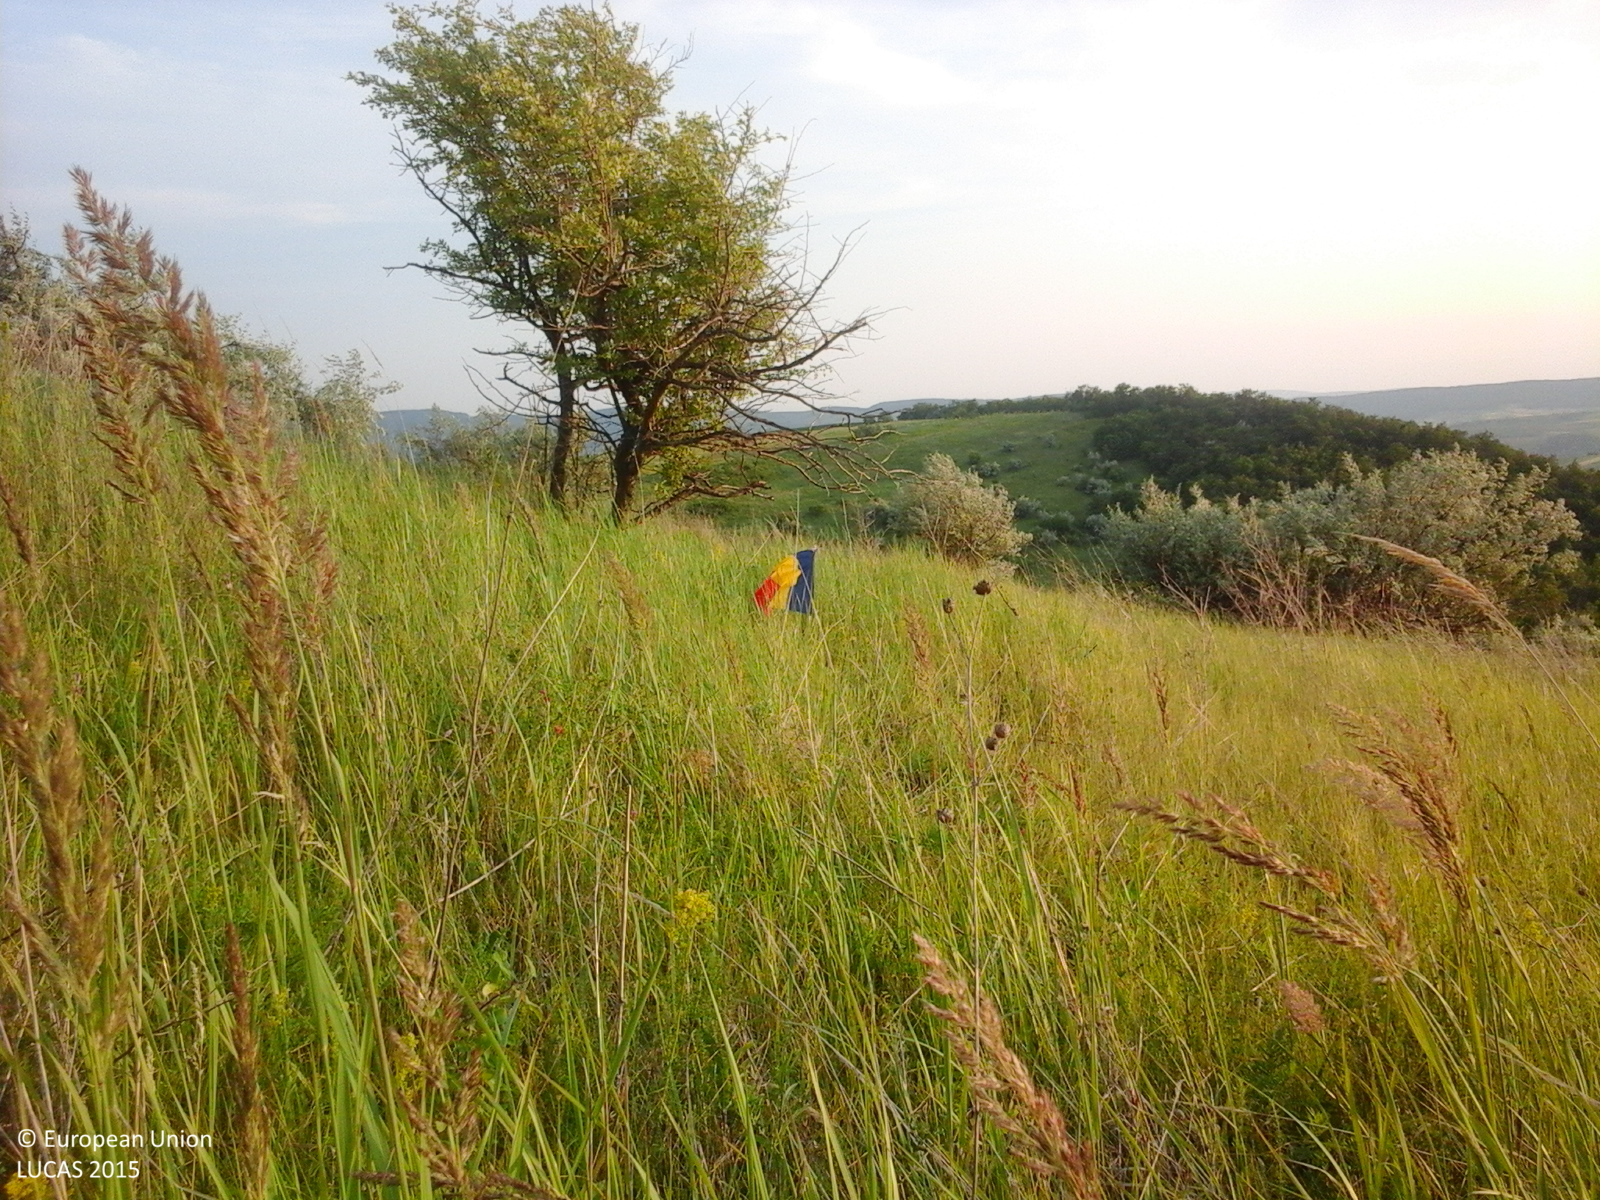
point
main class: Grassland
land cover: Grassland with sparse tree/shrub cover
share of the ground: > 75 %
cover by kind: herbaceous plants 90 %, broadleaved forest trees 5 %, shrubs 5 %
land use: Agriculture (excluding fallow land and kitchen gardens)
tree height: < 5 m
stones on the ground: 10 - 25 %
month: June
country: RO
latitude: 46.6906
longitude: 27.4359
